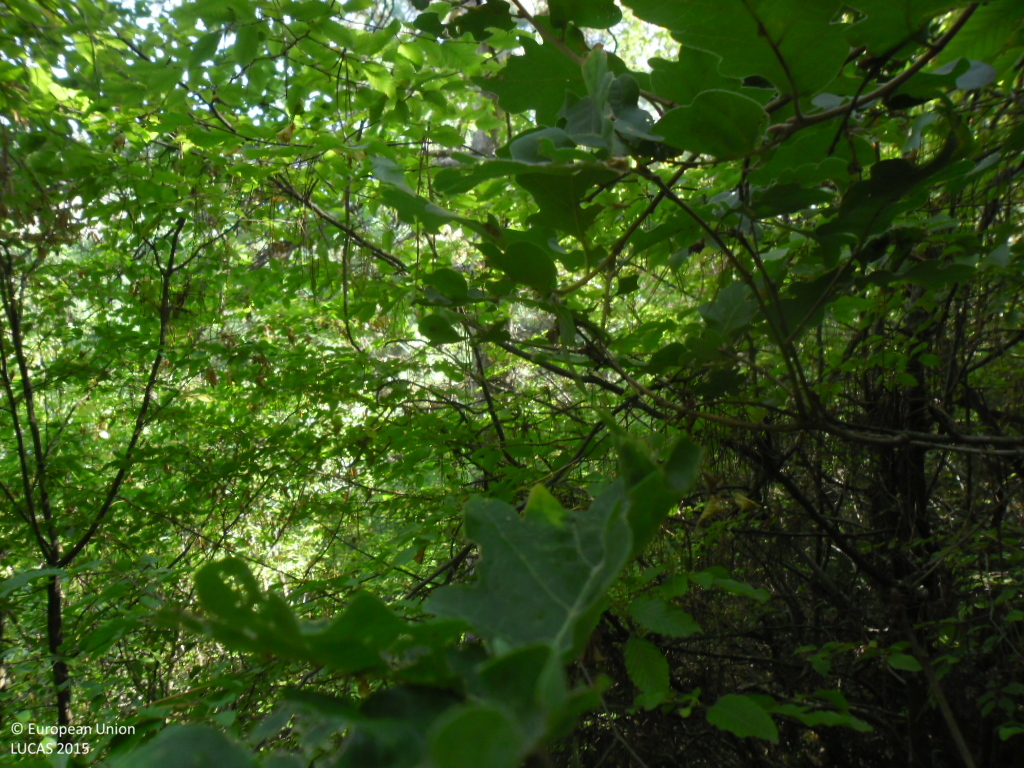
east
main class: Woodland
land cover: Other mixed woodland
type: hemiboreal forest and nemoral coniferous forest and mixed broadleaved-coniferous forest
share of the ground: > 75 %
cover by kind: coniferous forest trees 75 %, broadleaved forest trees 25 %
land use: Forestry
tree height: > 5 m
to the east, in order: Other mixed woodland; Artificial constructions in urban areas
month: September
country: BG
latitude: 41.7422
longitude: 23.1162
